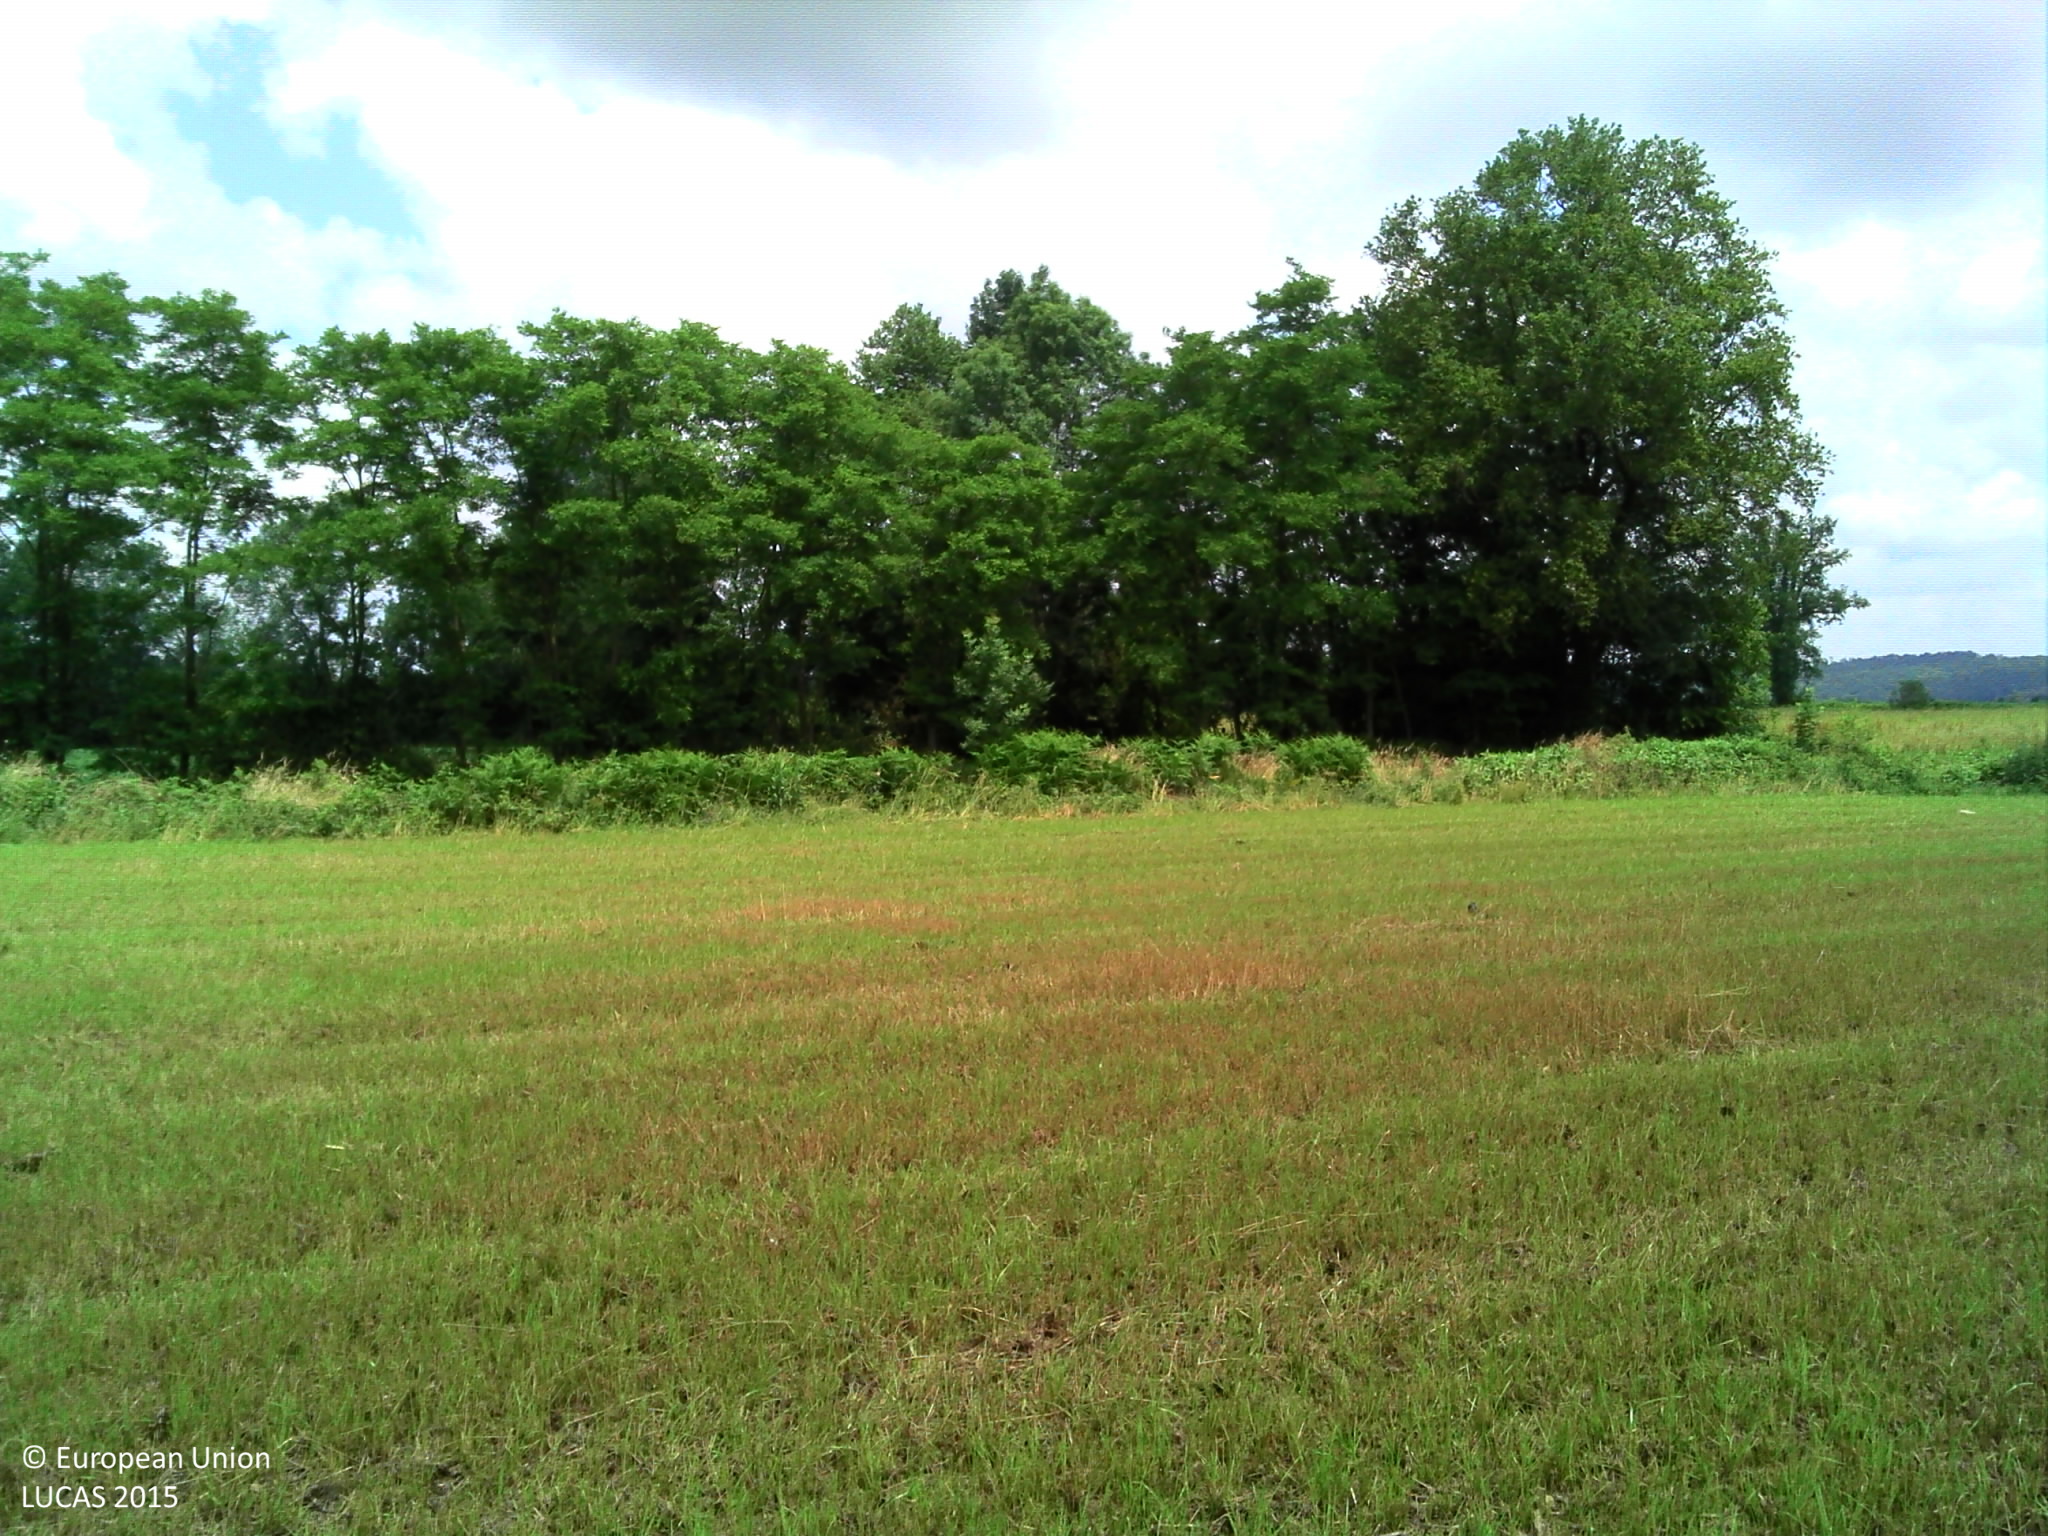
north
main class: Cropland
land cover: Temporary grasslands
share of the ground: > 75 %
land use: Agriculture (excluding fallow land and kitchen gardens)
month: June
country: FR
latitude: 43.2146
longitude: -0.1600
